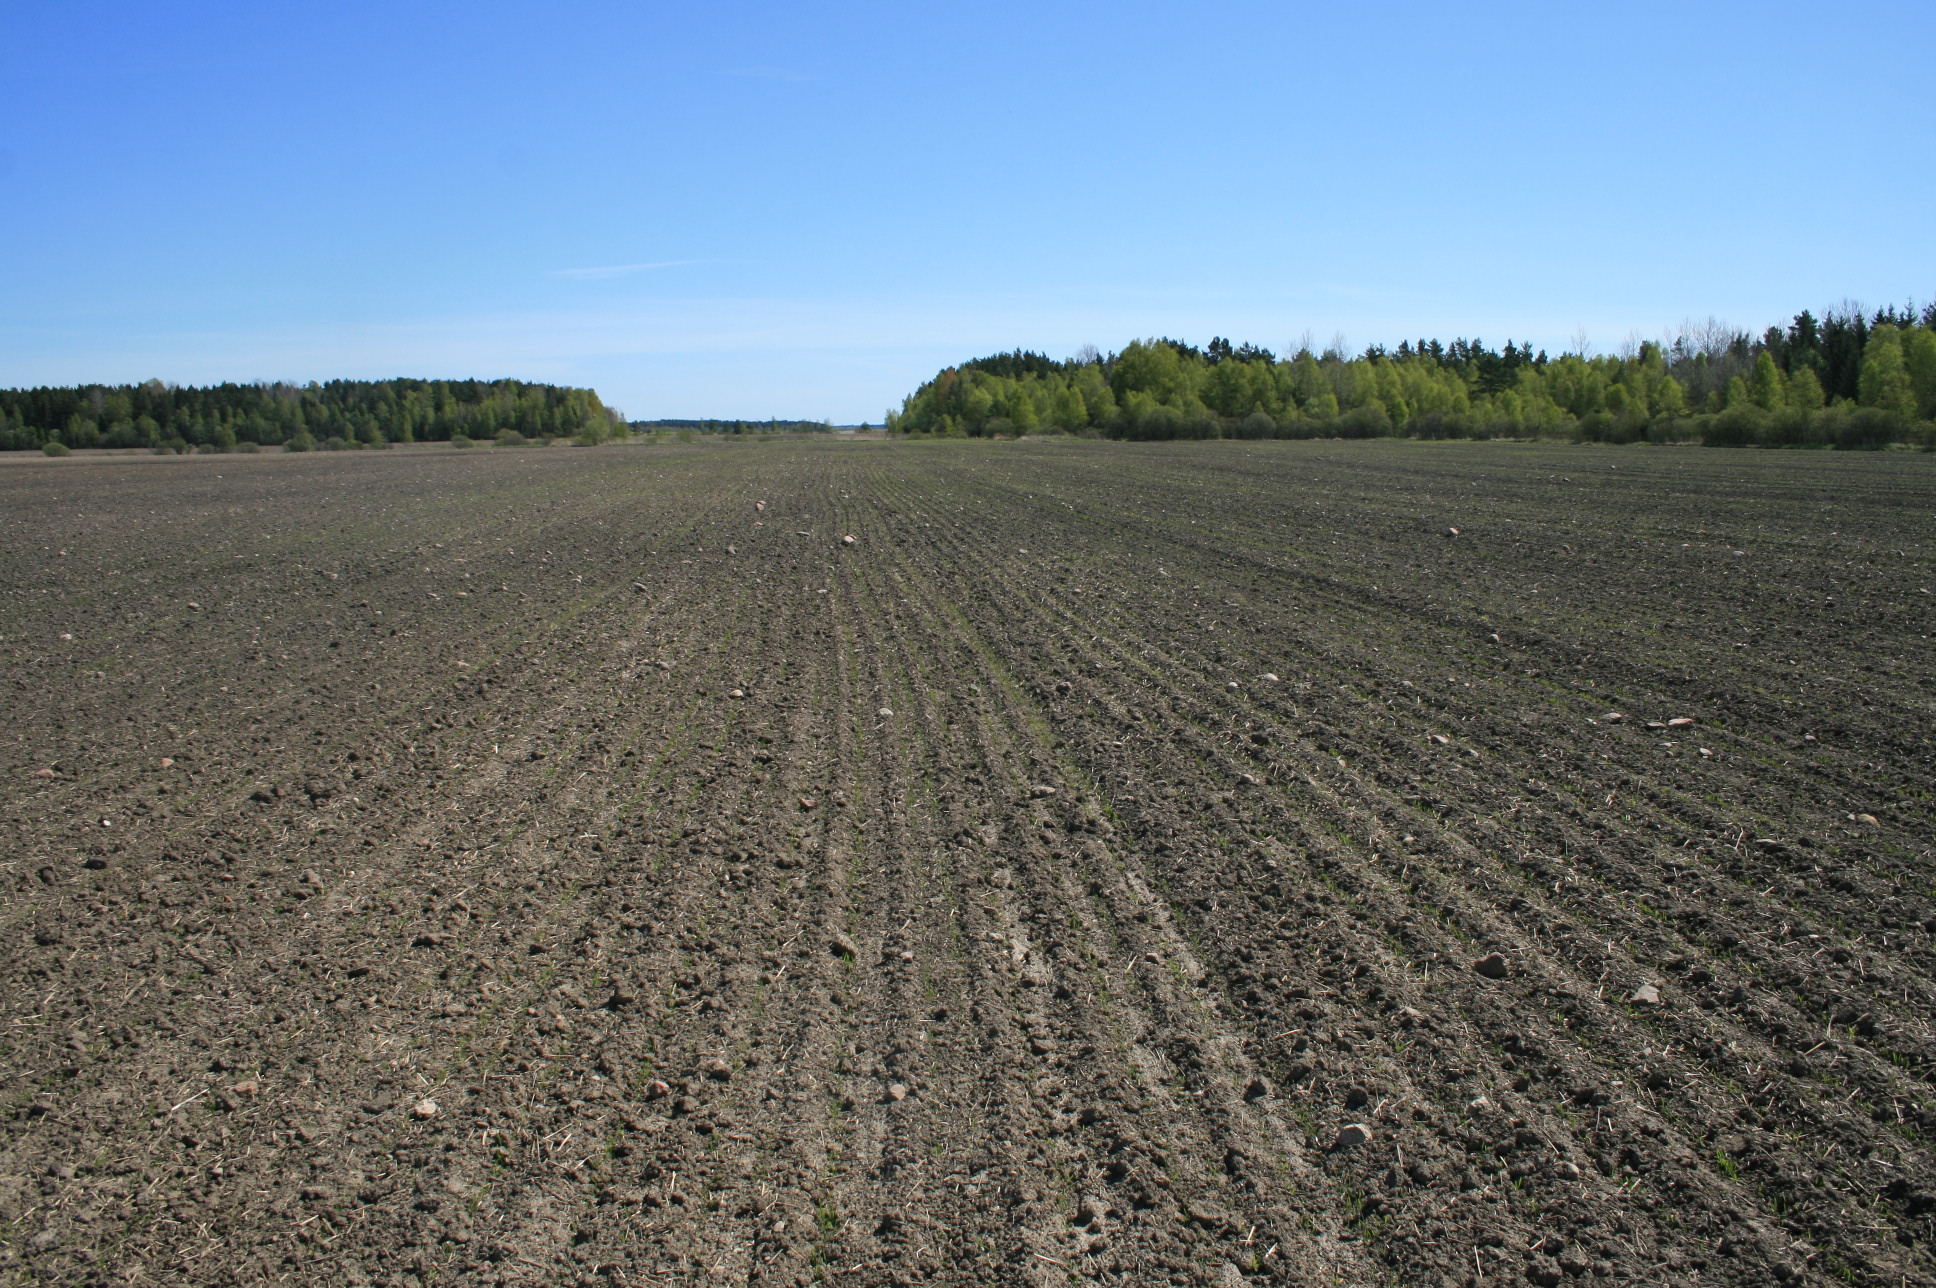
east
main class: Cropland
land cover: Common wheat
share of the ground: 10 - 25 %
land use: Agriculture (excluding fallow land and kitchen gardens)
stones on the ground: < 10 %
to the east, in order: Common wheat
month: May
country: LT
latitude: 56.1010
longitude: 21.3436
